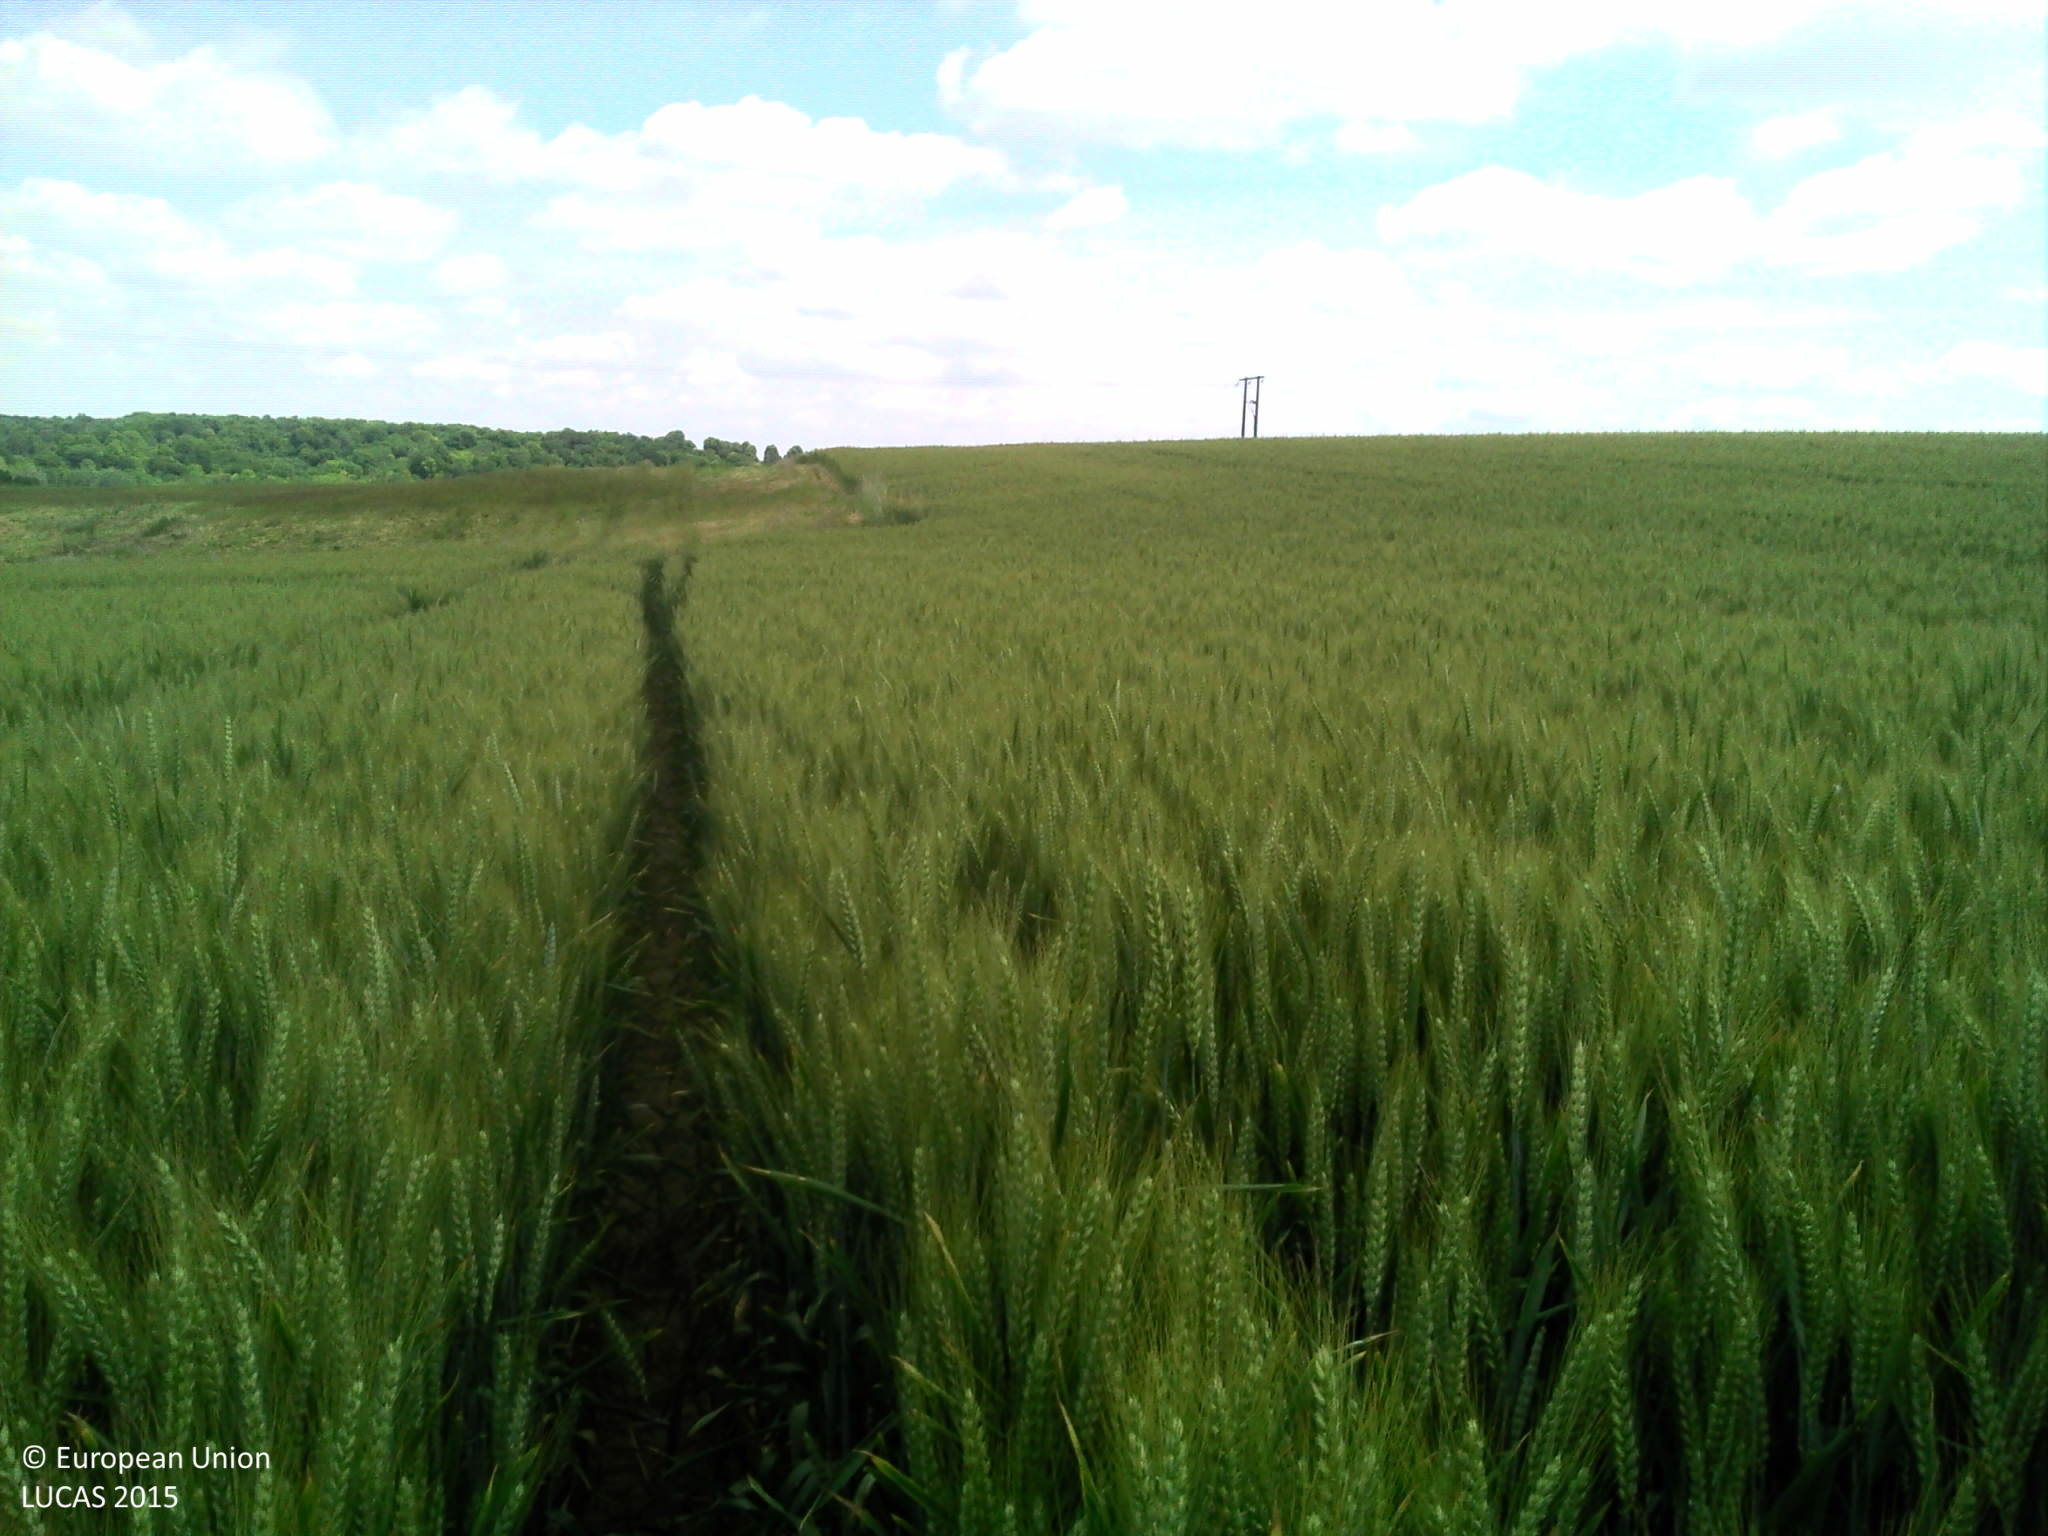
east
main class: Cropland
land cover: Durum wheat
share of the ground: > 75 %
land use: Agriculture (excluding fallow land and kitchen gardens)
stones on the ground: < 10 %
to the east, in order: Durum wheat; Grass margins; Paved roads, cycling and walking lanes; Grass margins; Electric lines; Sugar beet
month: June
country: FR
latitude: 49.6675
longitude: 2.5199
